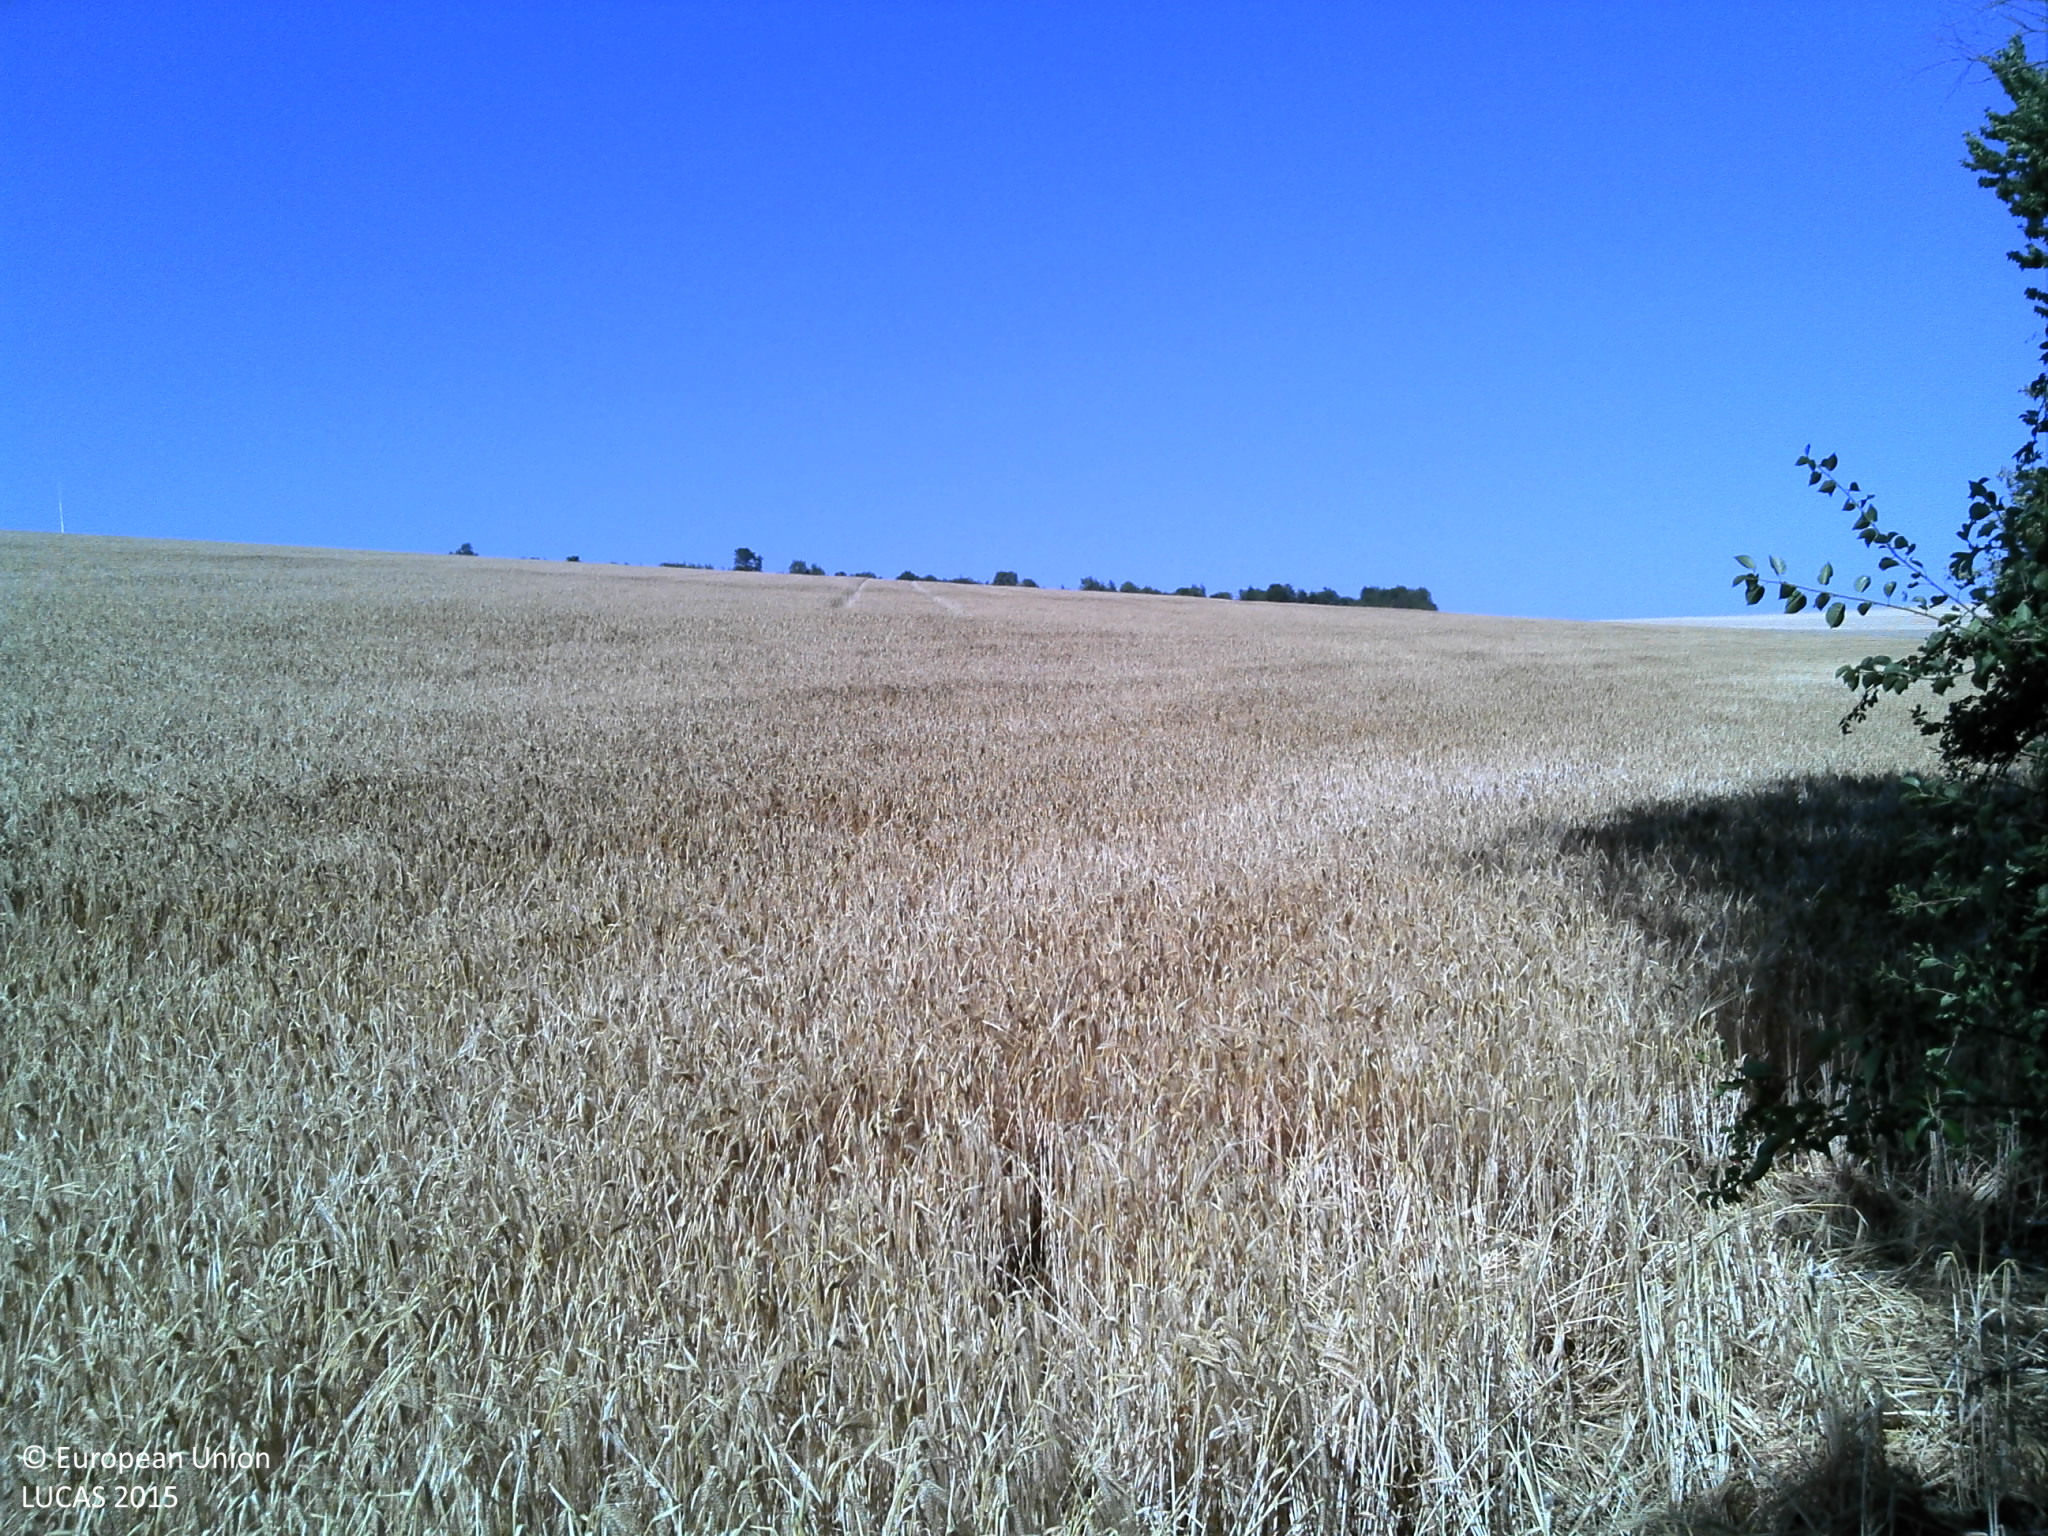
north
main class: Cropland
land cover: Barley
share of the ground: > 75 %
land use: Agriculture (excluding fallow land and kitchen gardens)
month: July
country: FR
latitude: 48.8519
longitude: 4.6685
